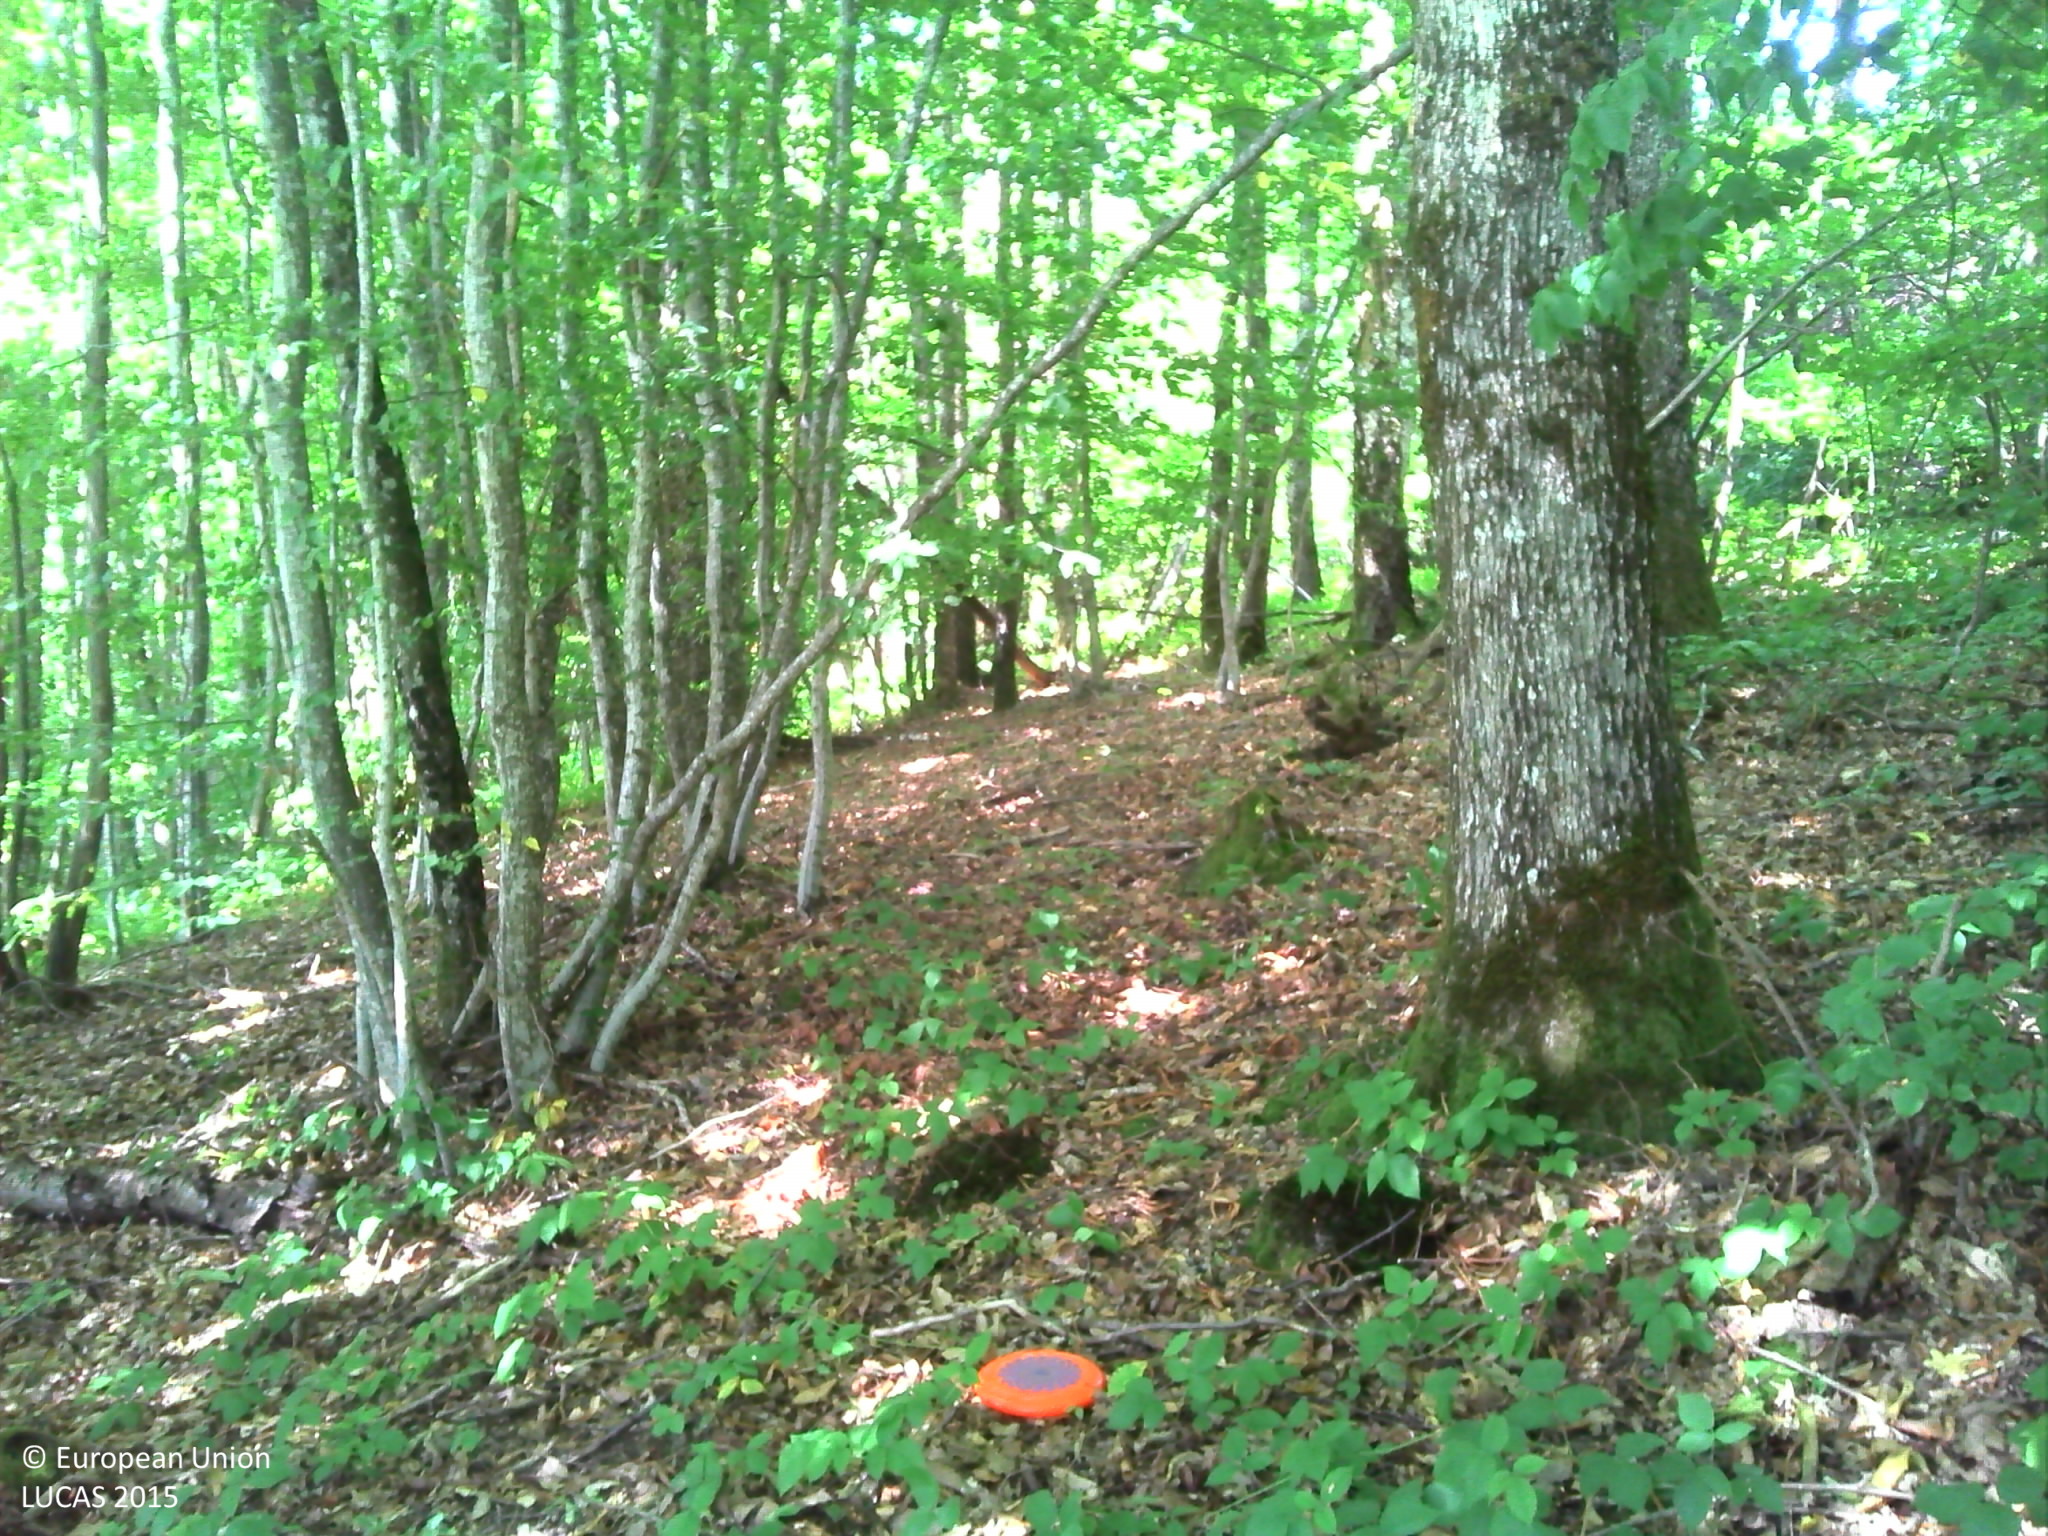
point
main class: Woodland
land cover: Broadleaved woodland
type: thermophilous deciduous forest
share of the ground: > 75 %
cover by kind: broadleaved forest trees 90 %, herbaceous plants 5 %, consolidated bare surface 5 %
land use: Forestry
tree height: > 5 m
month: July
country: FR
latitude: 45.4676
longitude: 5.6177
